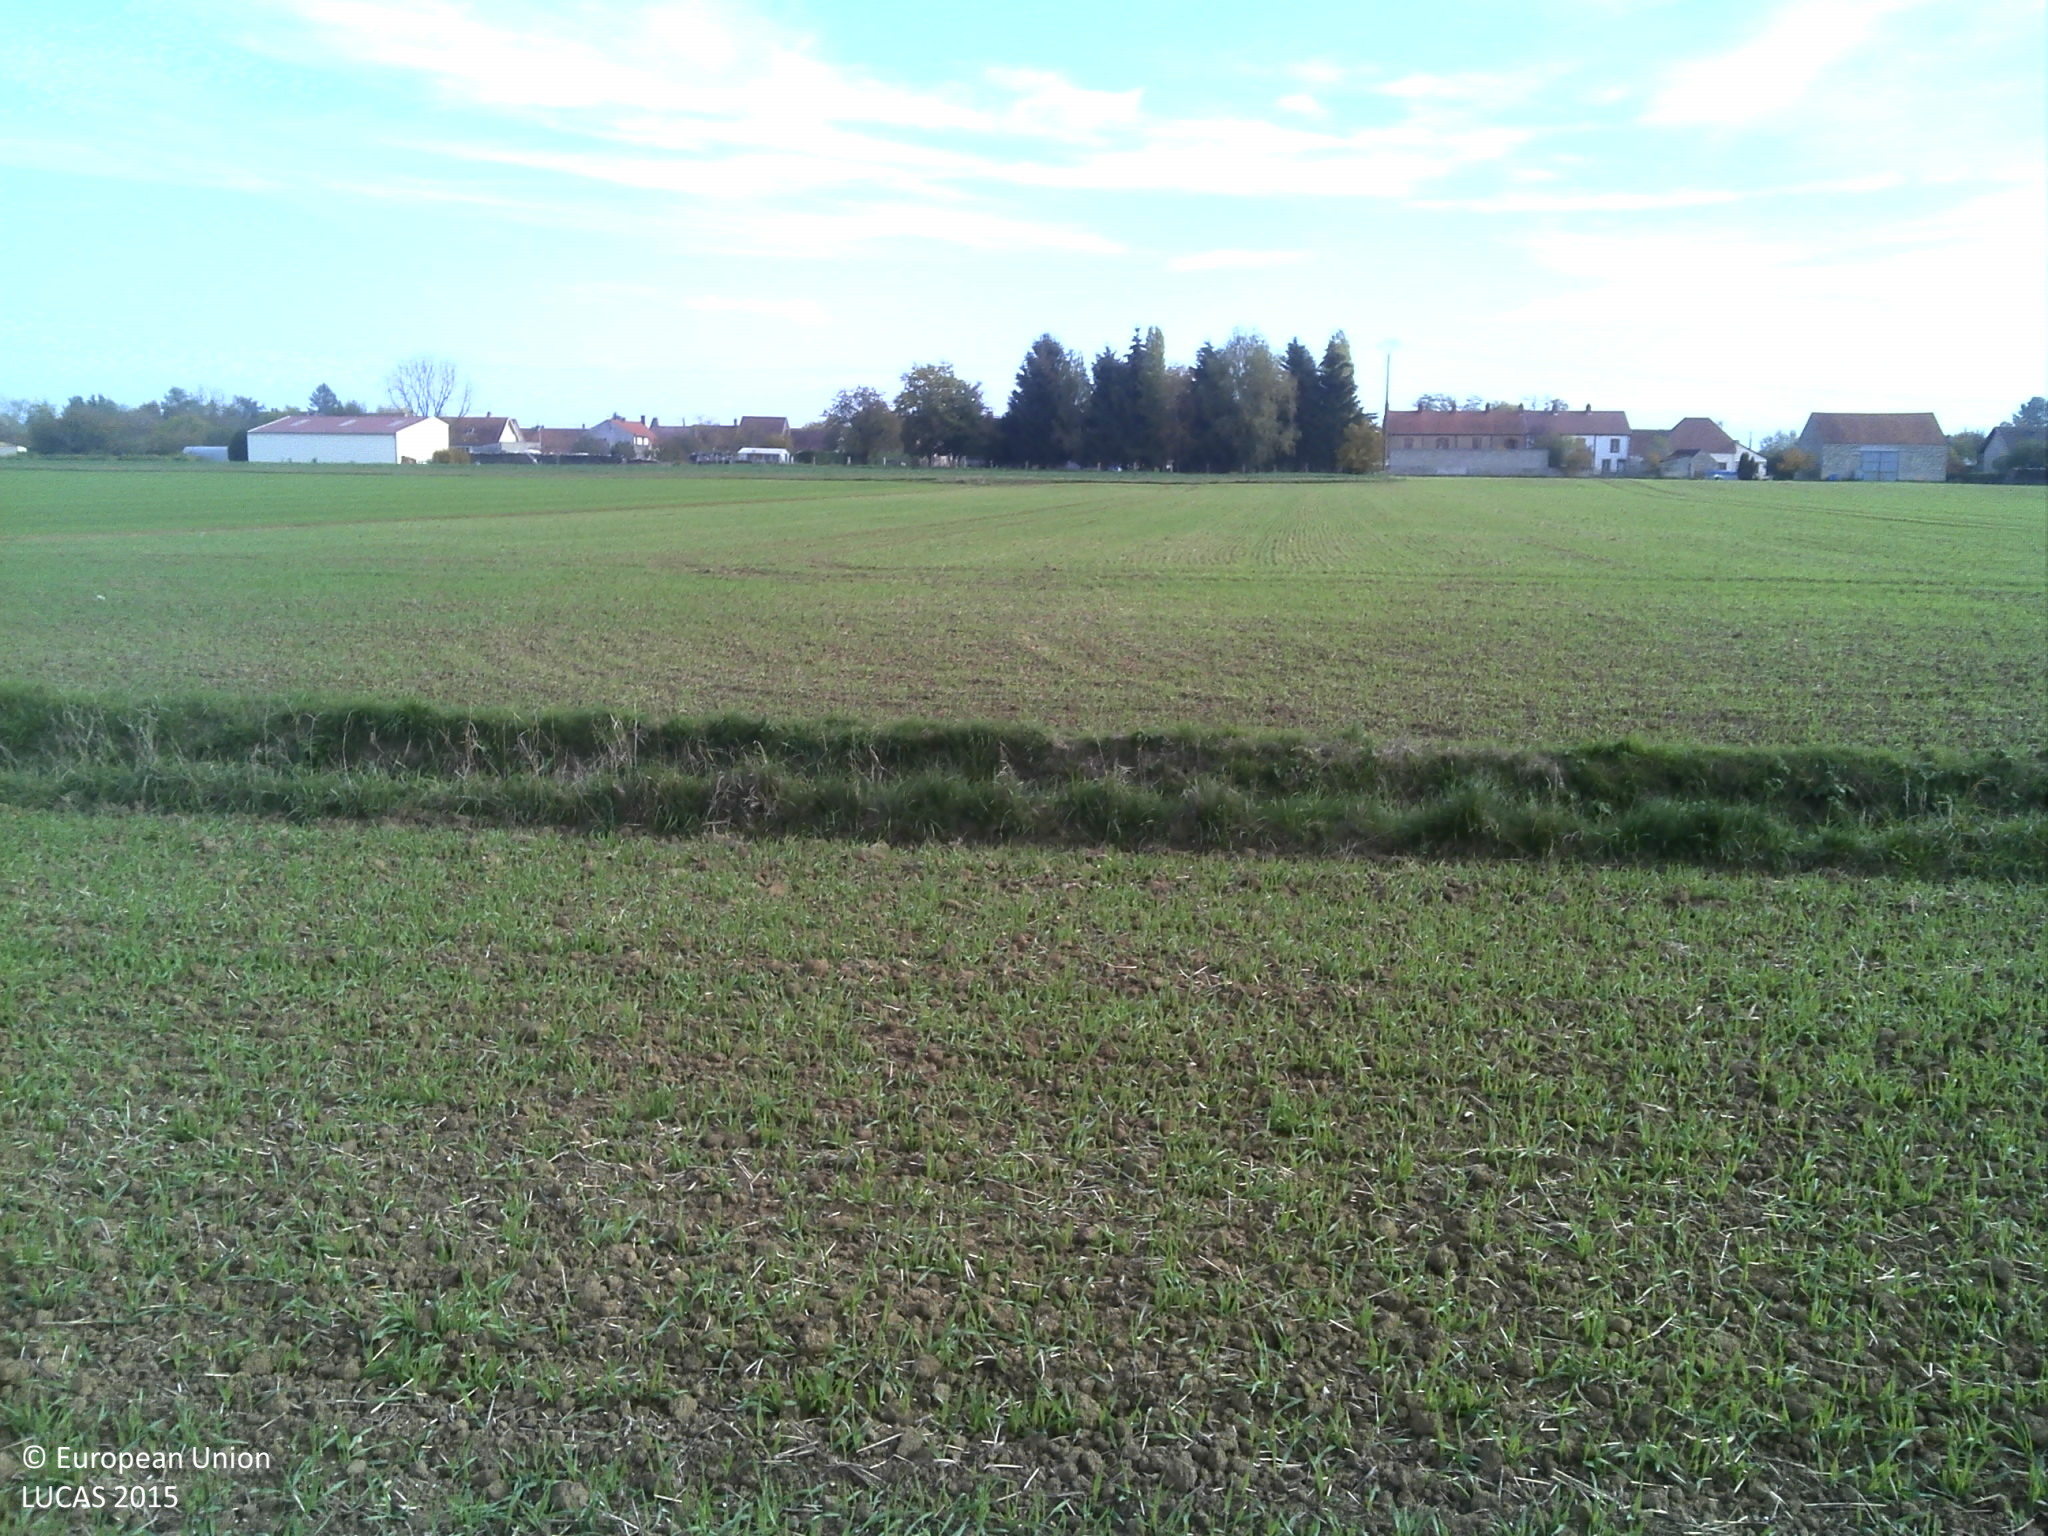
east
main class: Cropland
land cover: Common wheat
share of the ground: > 75 %
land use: Agriculture (excluding fallow land and kitchen gardens)
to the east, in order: Common wheat; Ditches and canals; Grass margins; Tracks; Grass margins; Common wheat; Rape and turnip rape; Electric lines; Rape and turnip rape
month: October
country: FR
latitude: 47.1484
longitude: 5.2668
